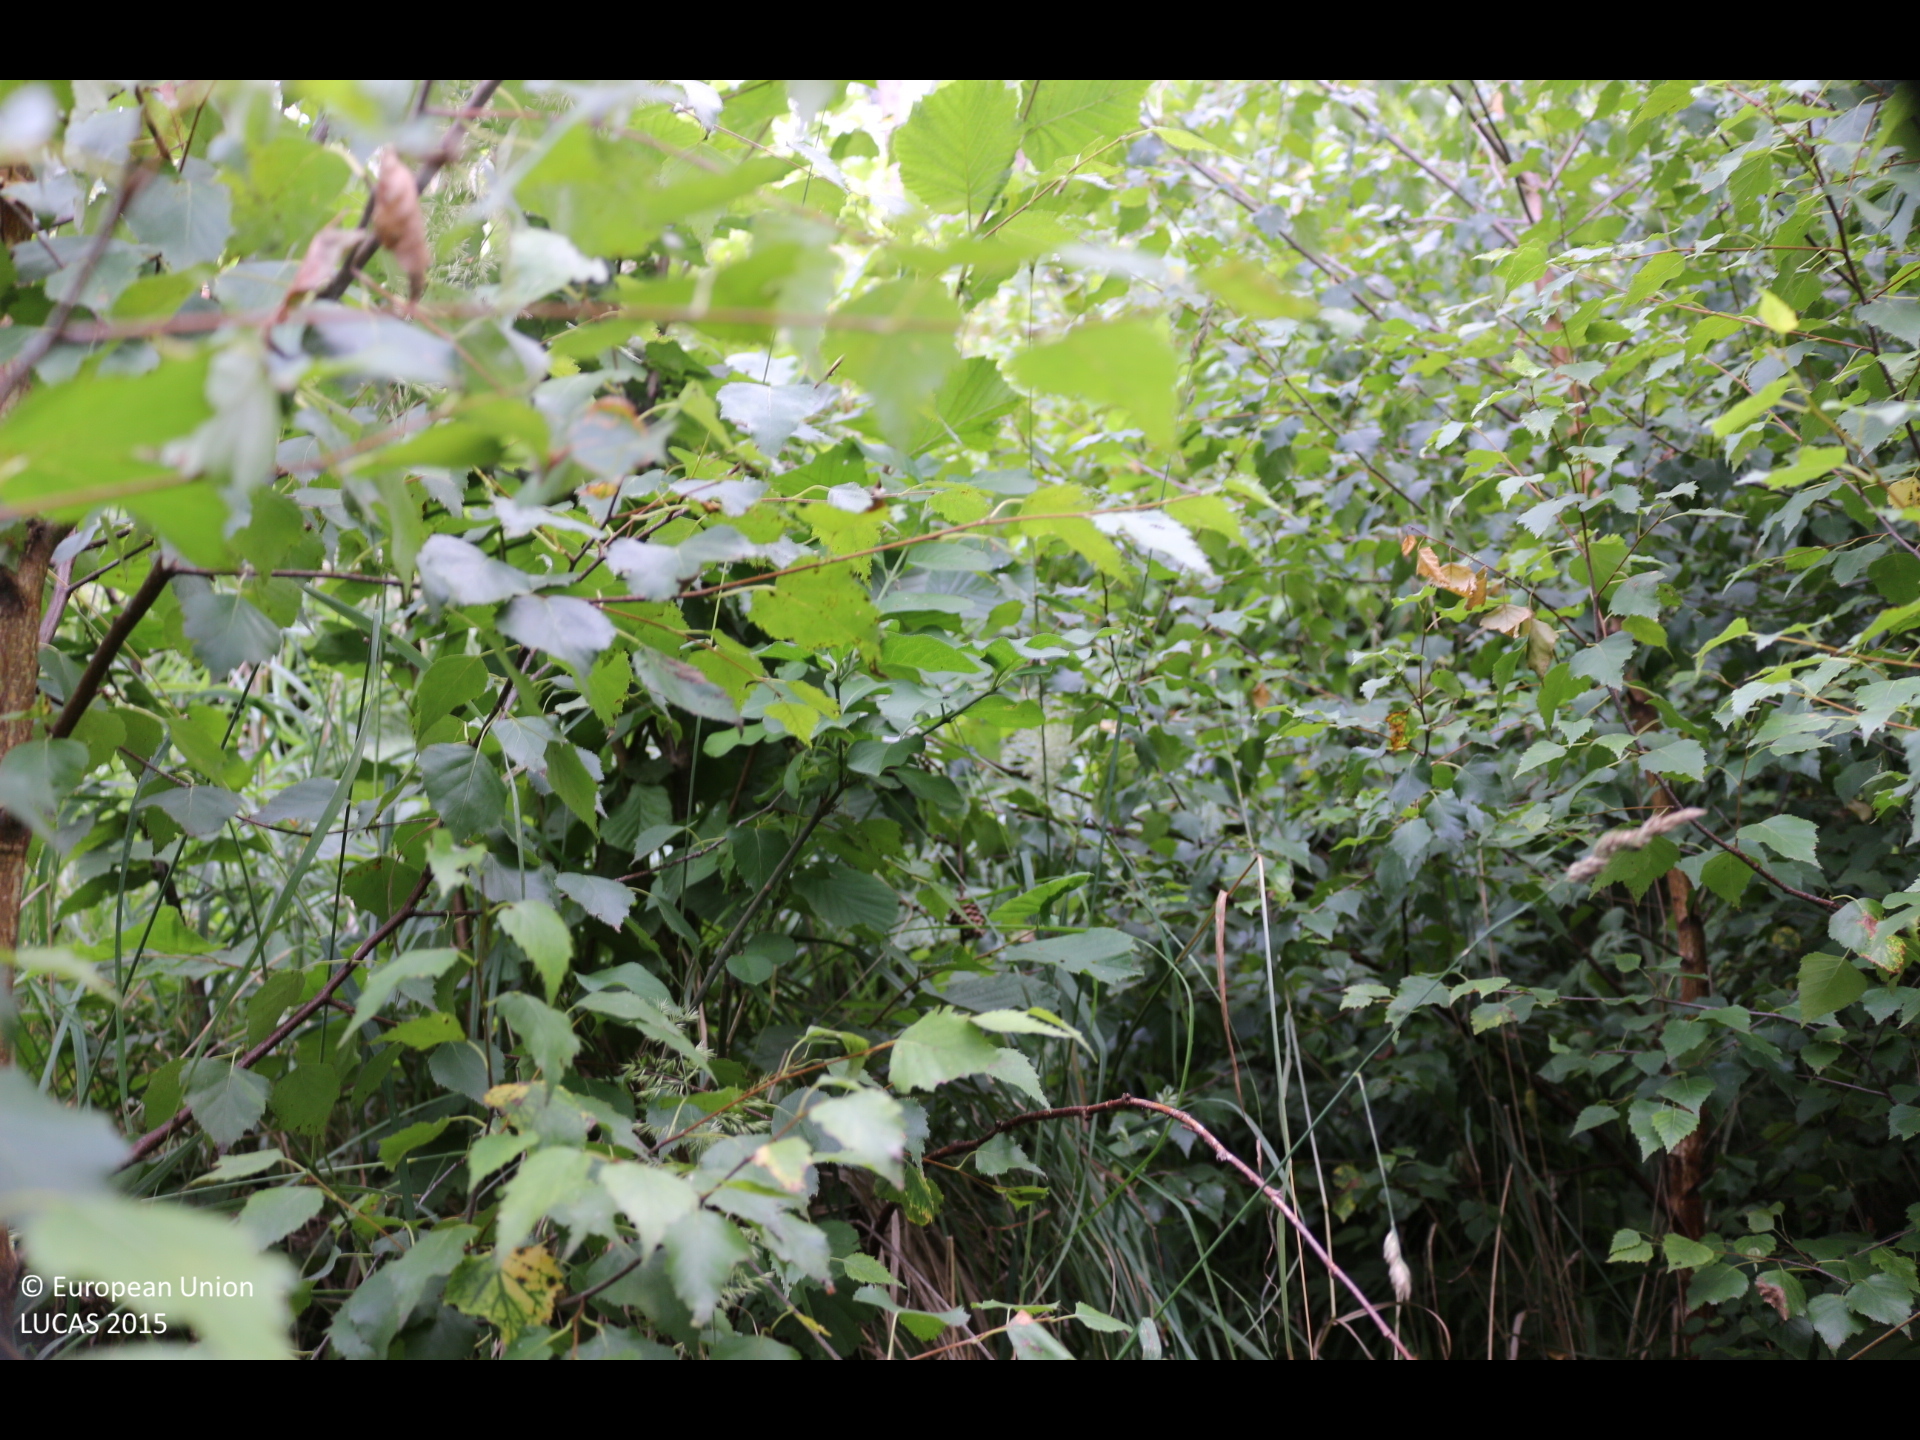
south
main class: Shrubland
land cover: Shrubland with sparse tree cover
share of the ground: > 75 %
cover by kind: shrubs 80 %, herbaceous plants 15 %, broadleaved forest trees 5 %
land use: Forestry
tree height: < 5 m
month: July
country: AT
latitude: 46.8168
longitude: 13.4969
